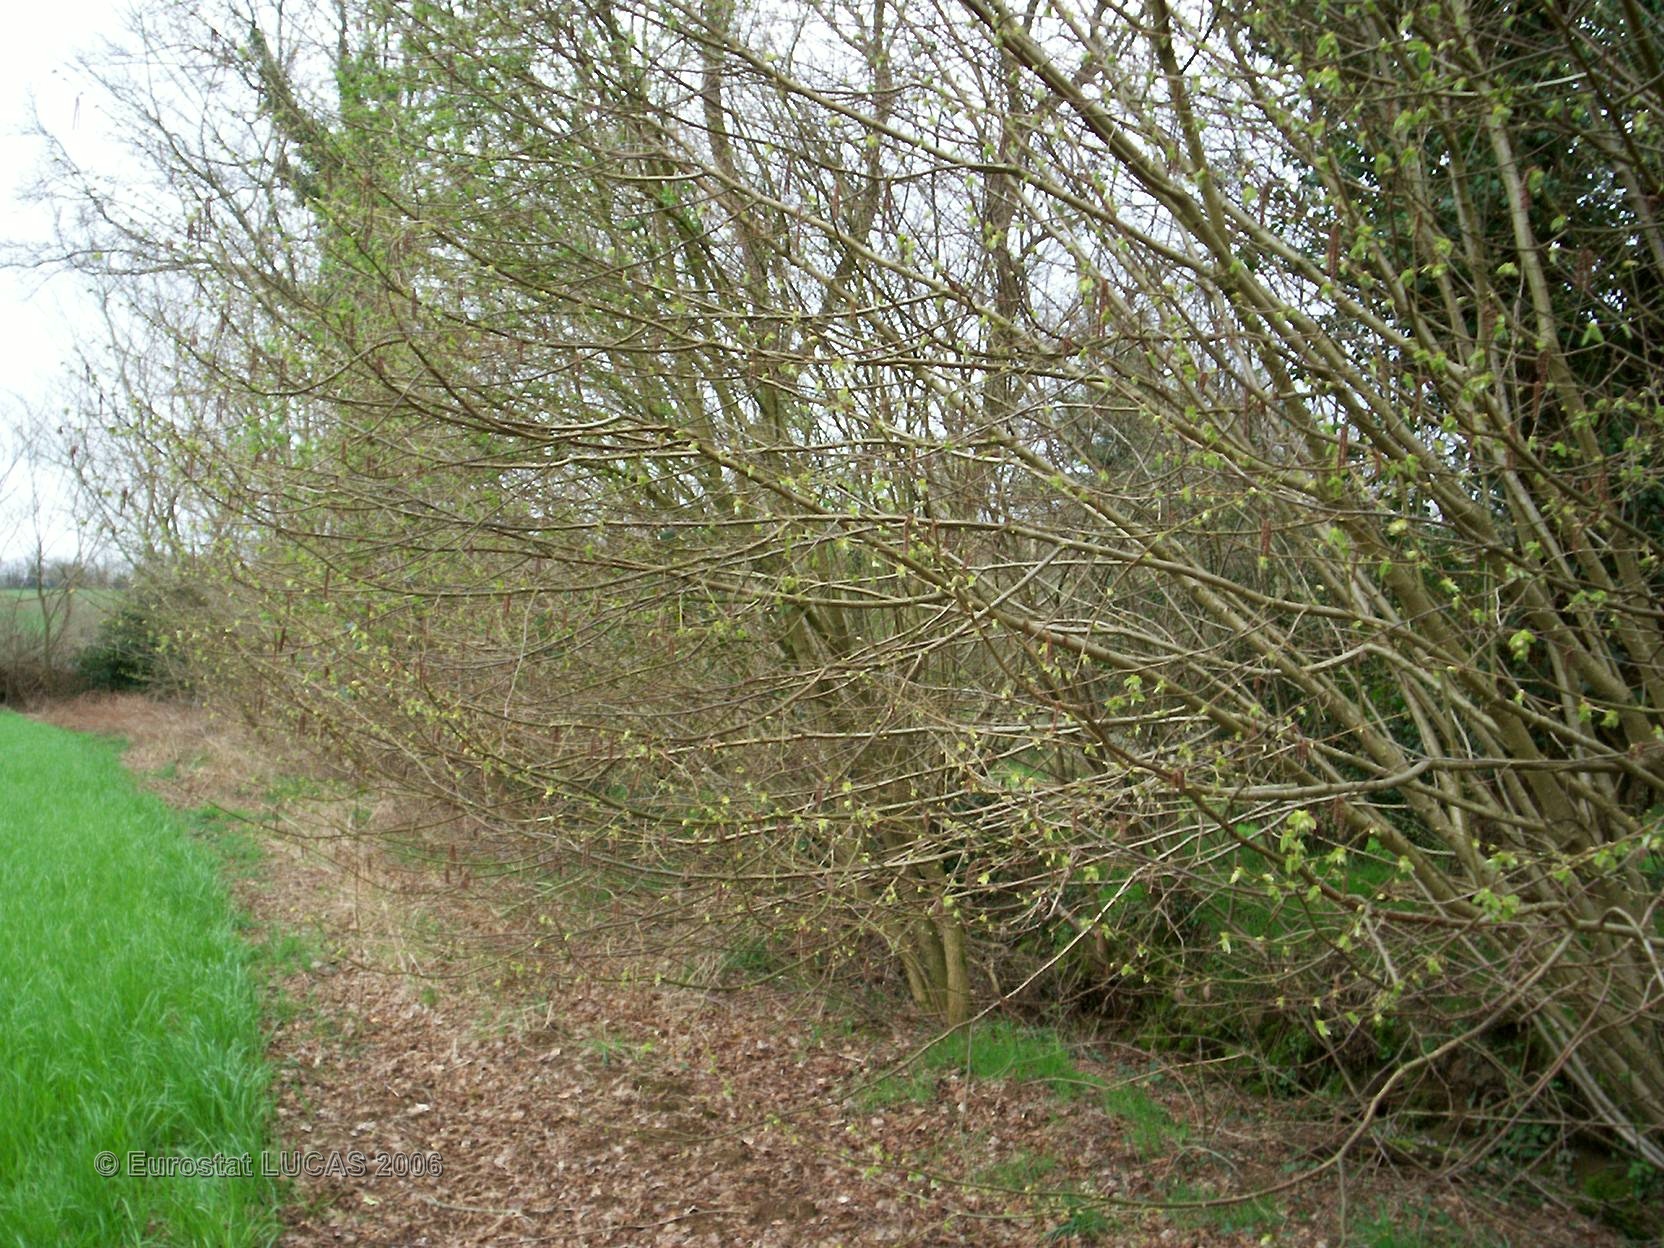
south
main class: Grassland
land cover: Grassland without tree/shrub cover
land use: Agriculture (excluding fallow land and kitchen gardens)
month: April
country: FR
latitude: 47.9321
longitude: -3.5288
